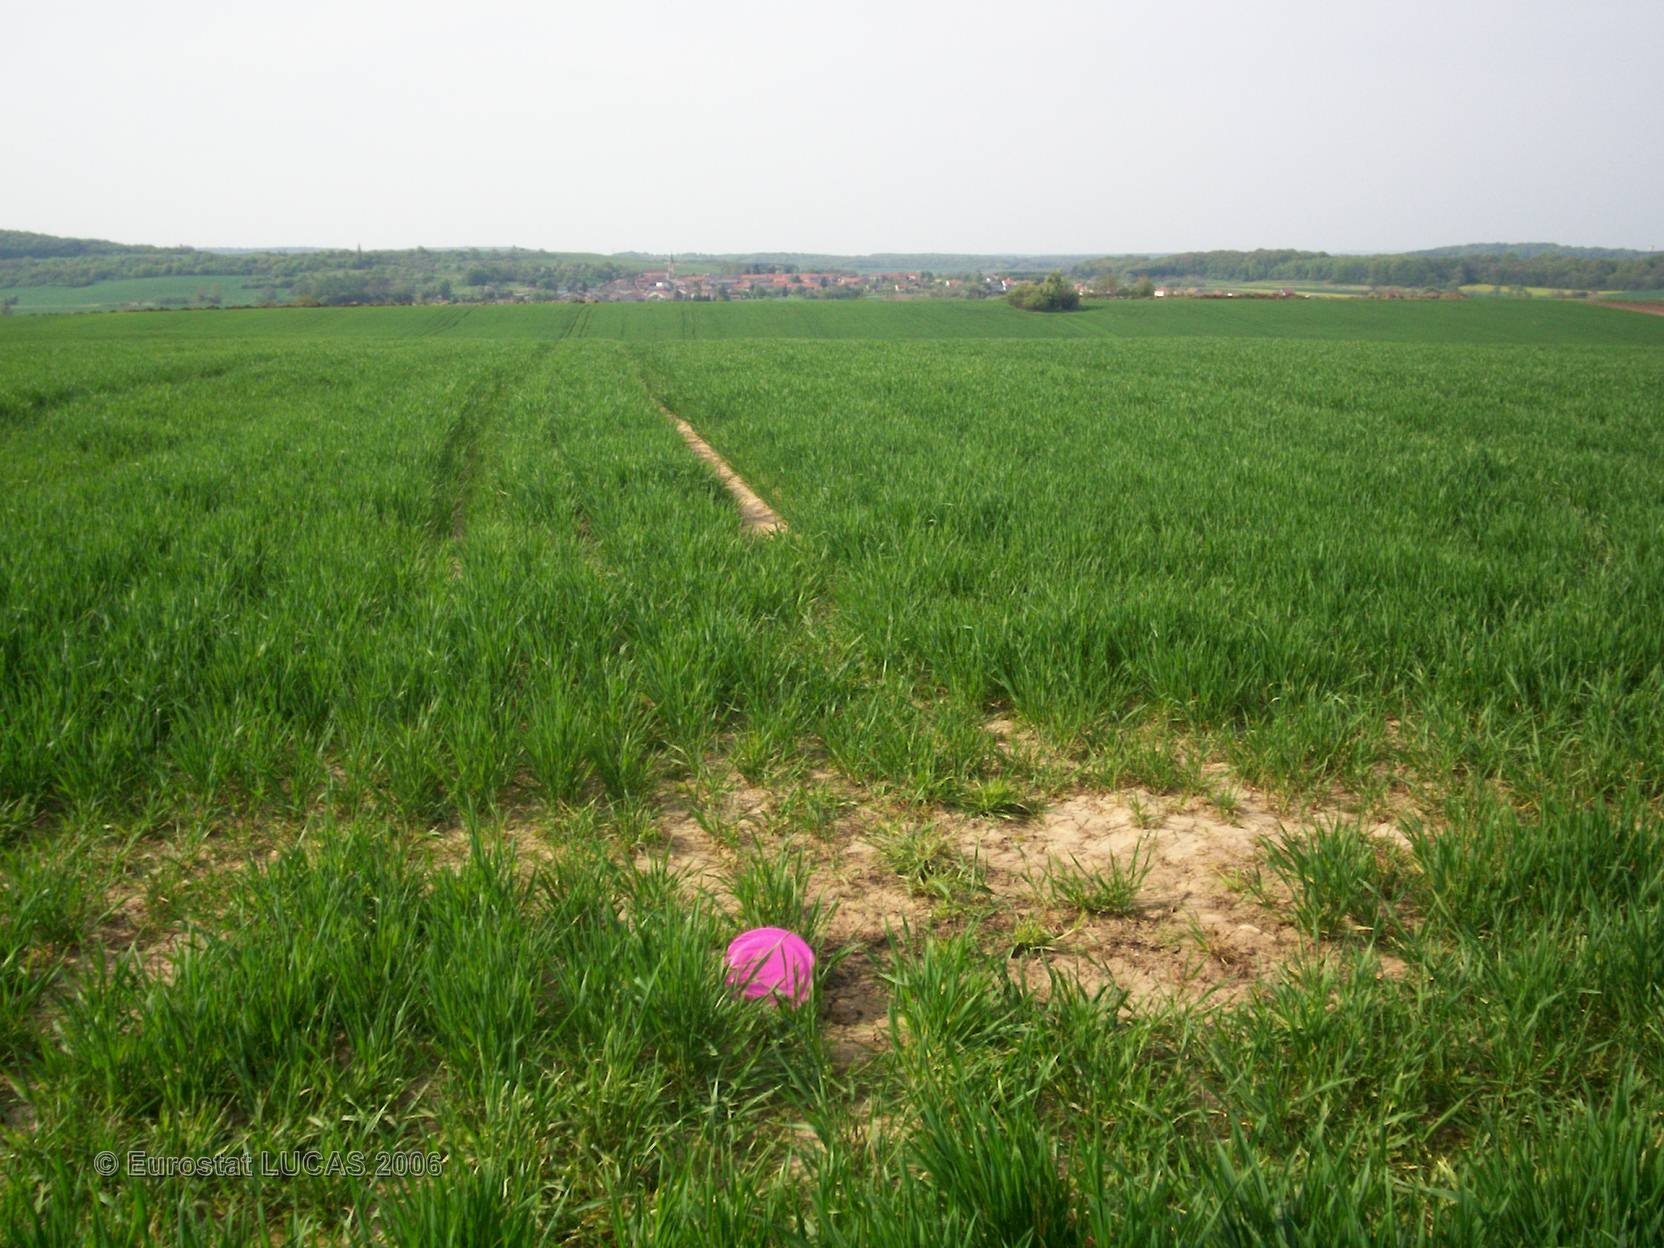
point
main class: Cropland
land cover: Common wheat
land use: Agriculture (excluding fallow land and kitchen gardens)
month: May
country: FR
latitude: 49.2467
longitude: 6.4420
